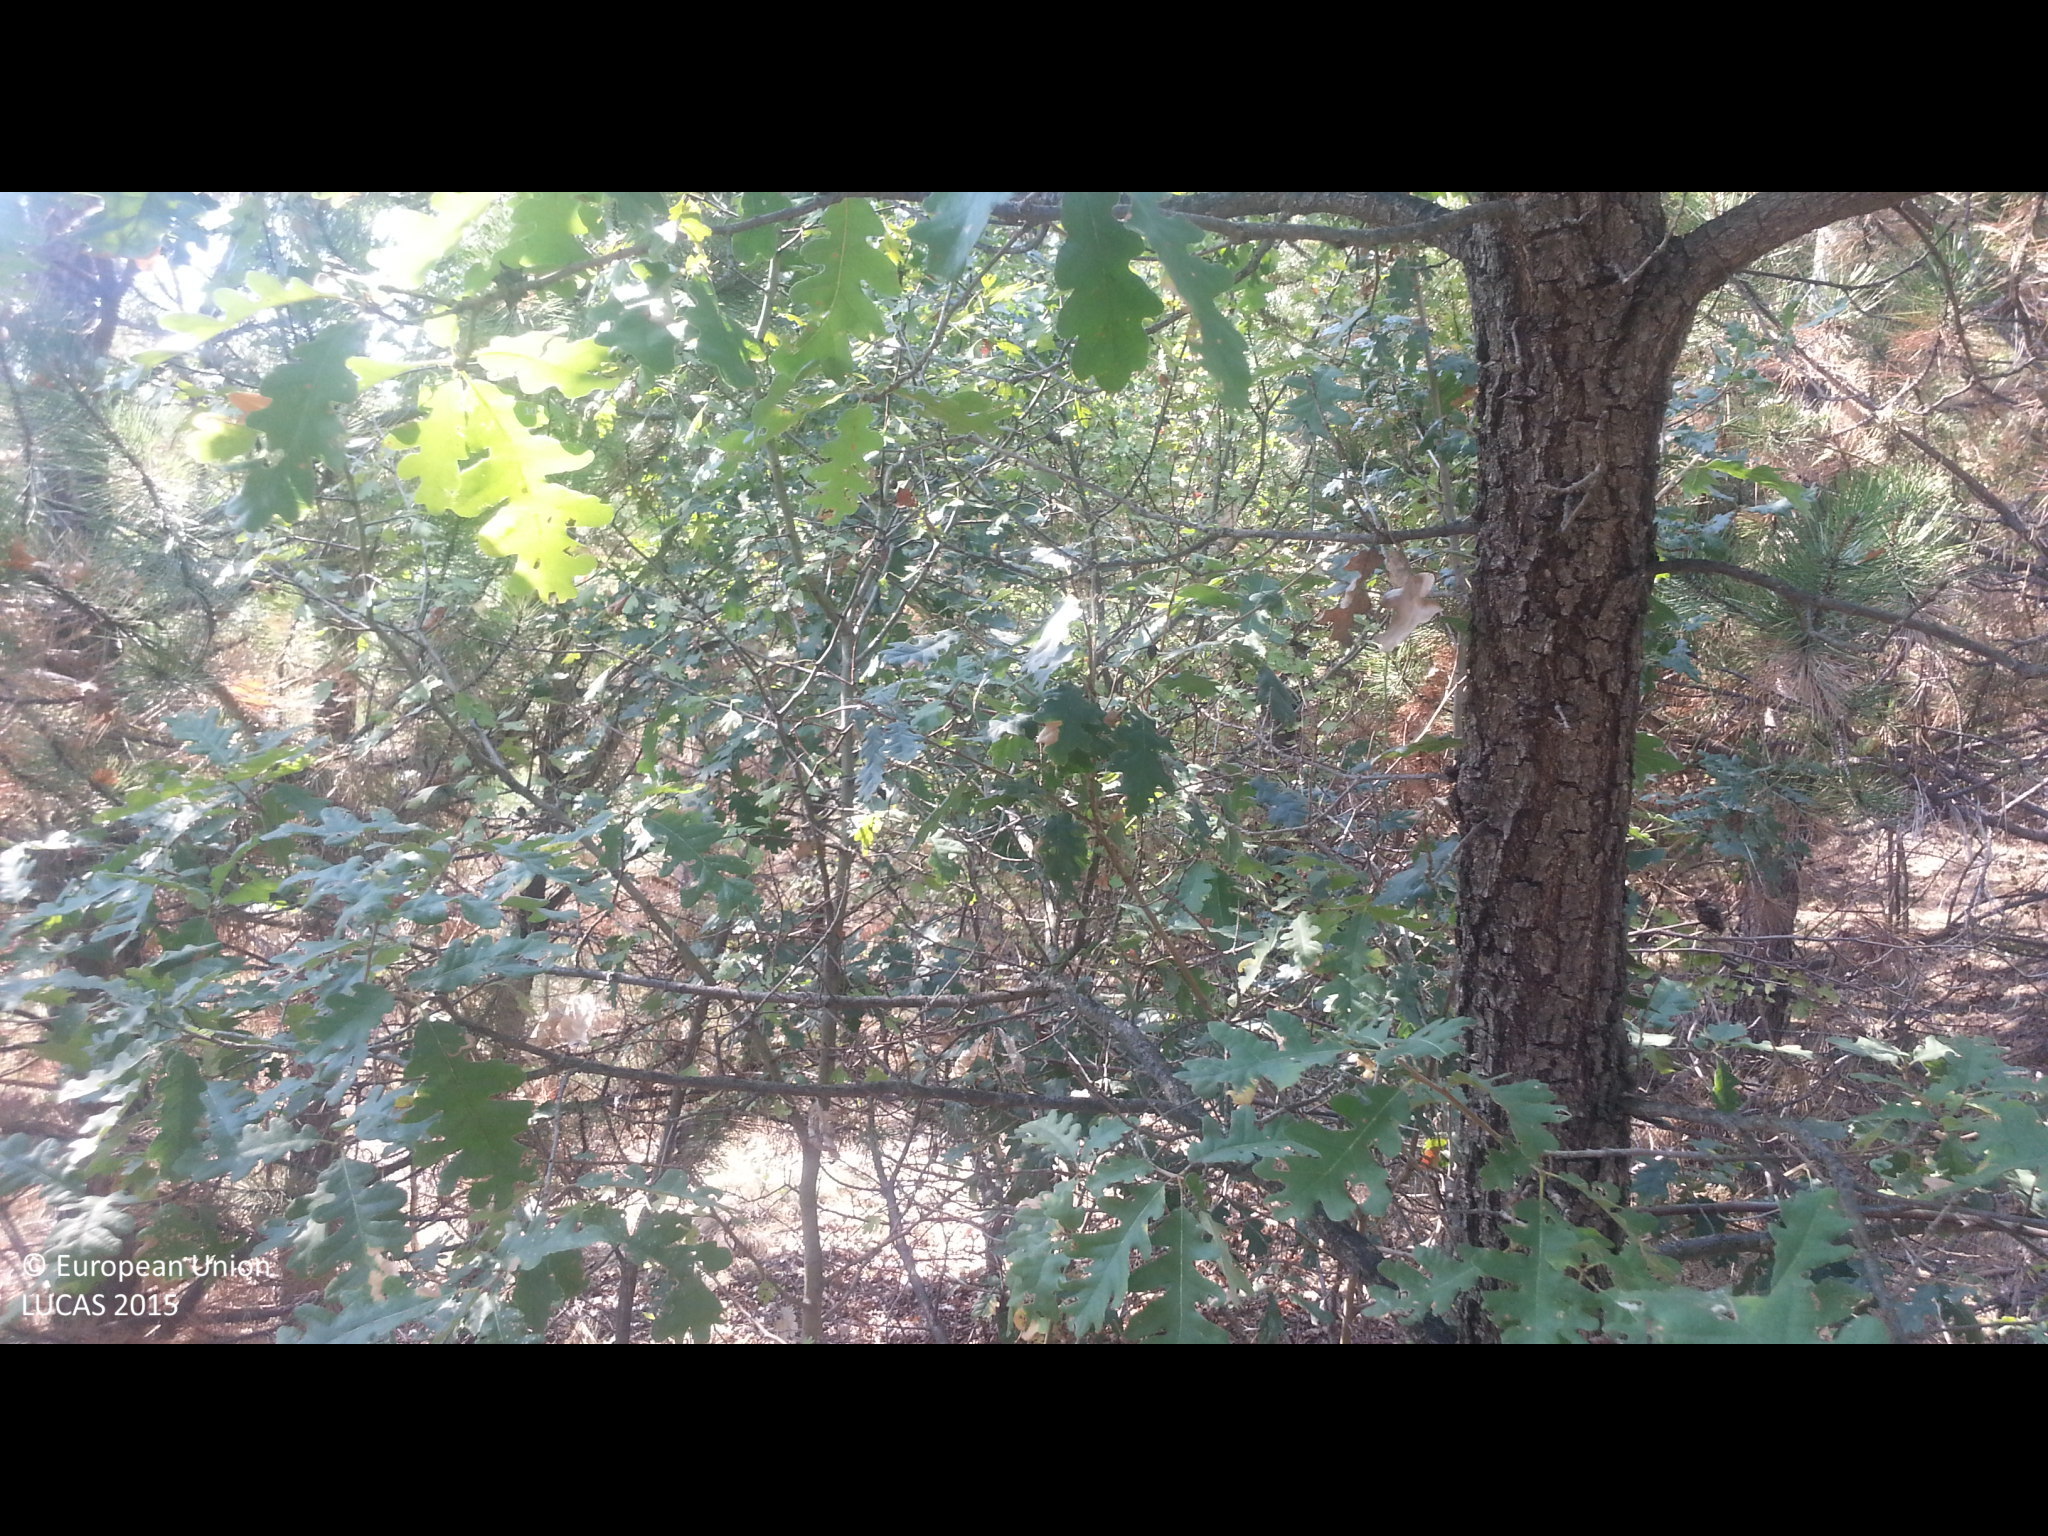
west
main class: Woodland
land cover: Other mixed woodland
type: hemiboreal forest and nemoral coniferous forest and mixed broadleaved-coniferous forest
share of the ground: > 75 %
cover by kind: coniferous forest trees 75 %, broadleaved forest trees 25 %
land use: Forestry
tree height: < 5 m
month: August
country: BG
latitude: 42.3680
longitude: 23.0814
